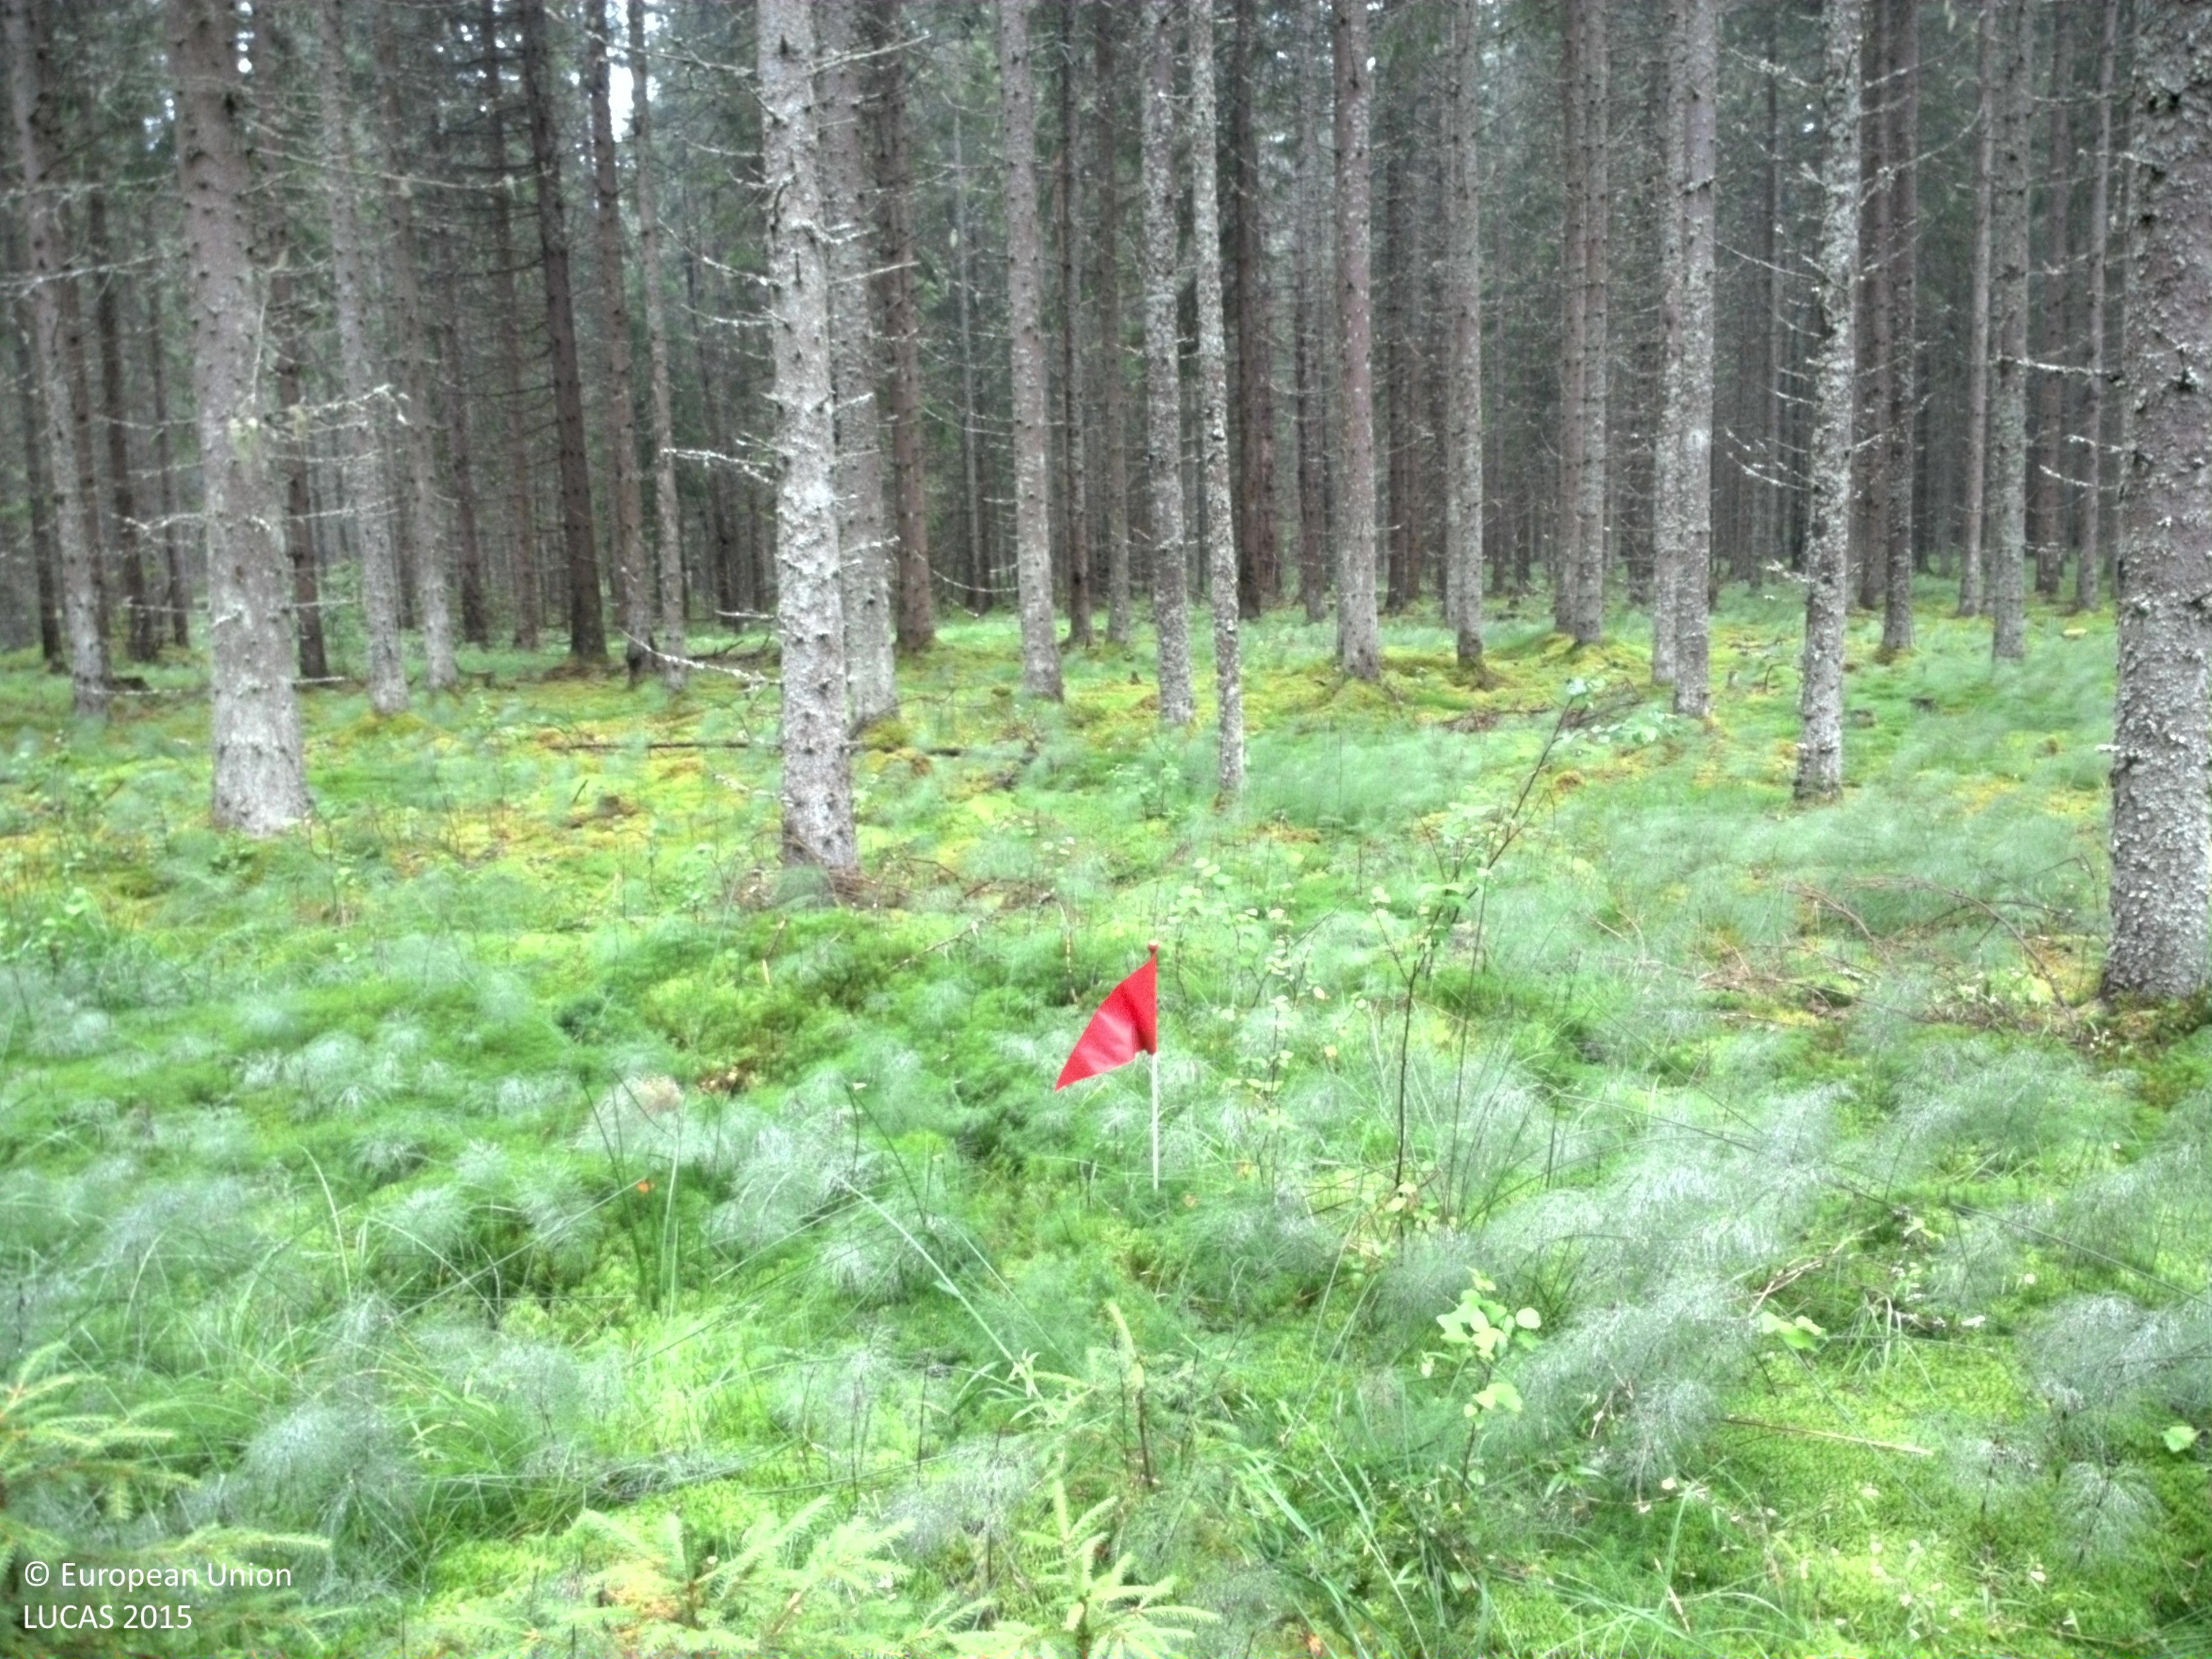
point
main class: Woodland
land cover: Spruce dominated coniferous woodland
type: boreal forest
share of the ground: 50 - 75 %
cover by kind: coniferous forest trees 65 %, shrubs 20 %, lichens and mosses 10 %, broadleaved forest trees 5 %
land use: Forestry
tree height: > 5 m
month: August
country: SE
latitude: 59.4602
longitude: 13.1859
